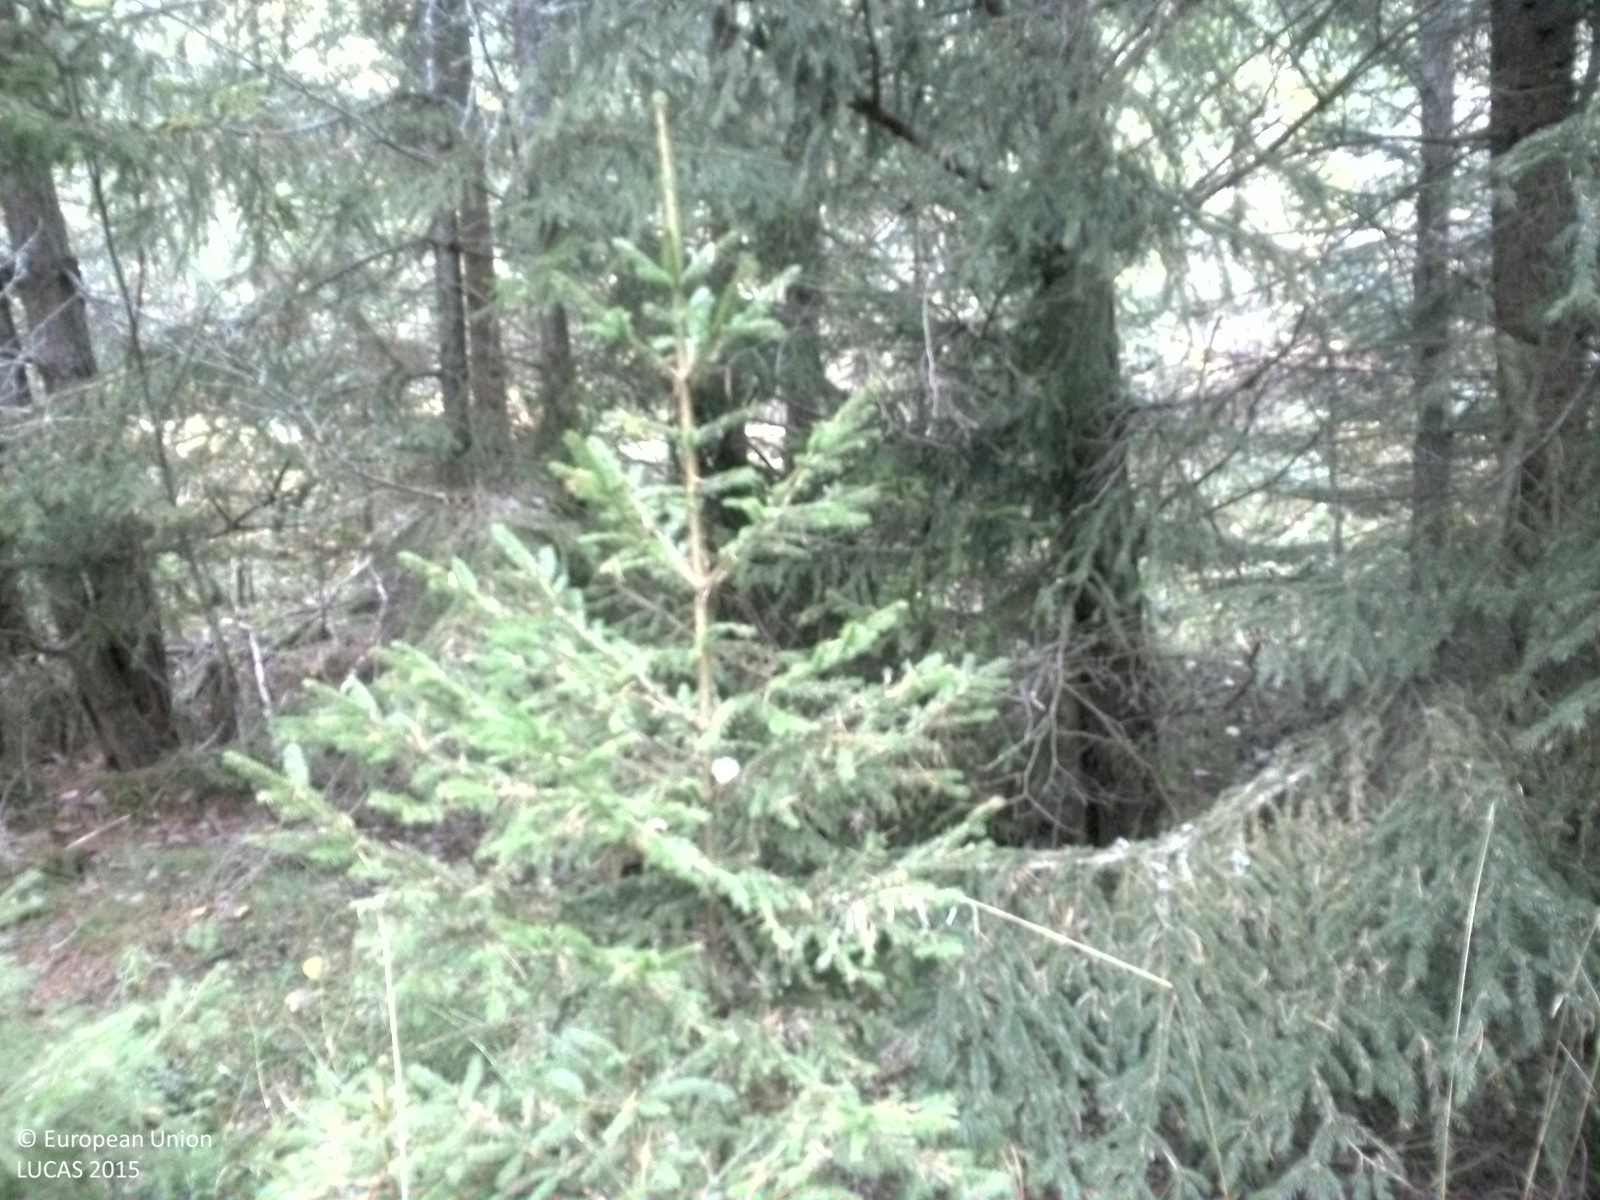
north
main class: Woodland
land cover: Pine dominated coniferous woodland
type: boreal forest
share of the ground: 50 - 75 %
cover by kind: coniferous forest trees 50 %, herbaceous plants 40 %, lichens and mosses 10 %
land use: Forestry
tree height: < 5 m
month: September
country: SE
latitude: 58.6542
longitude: 16.9425
